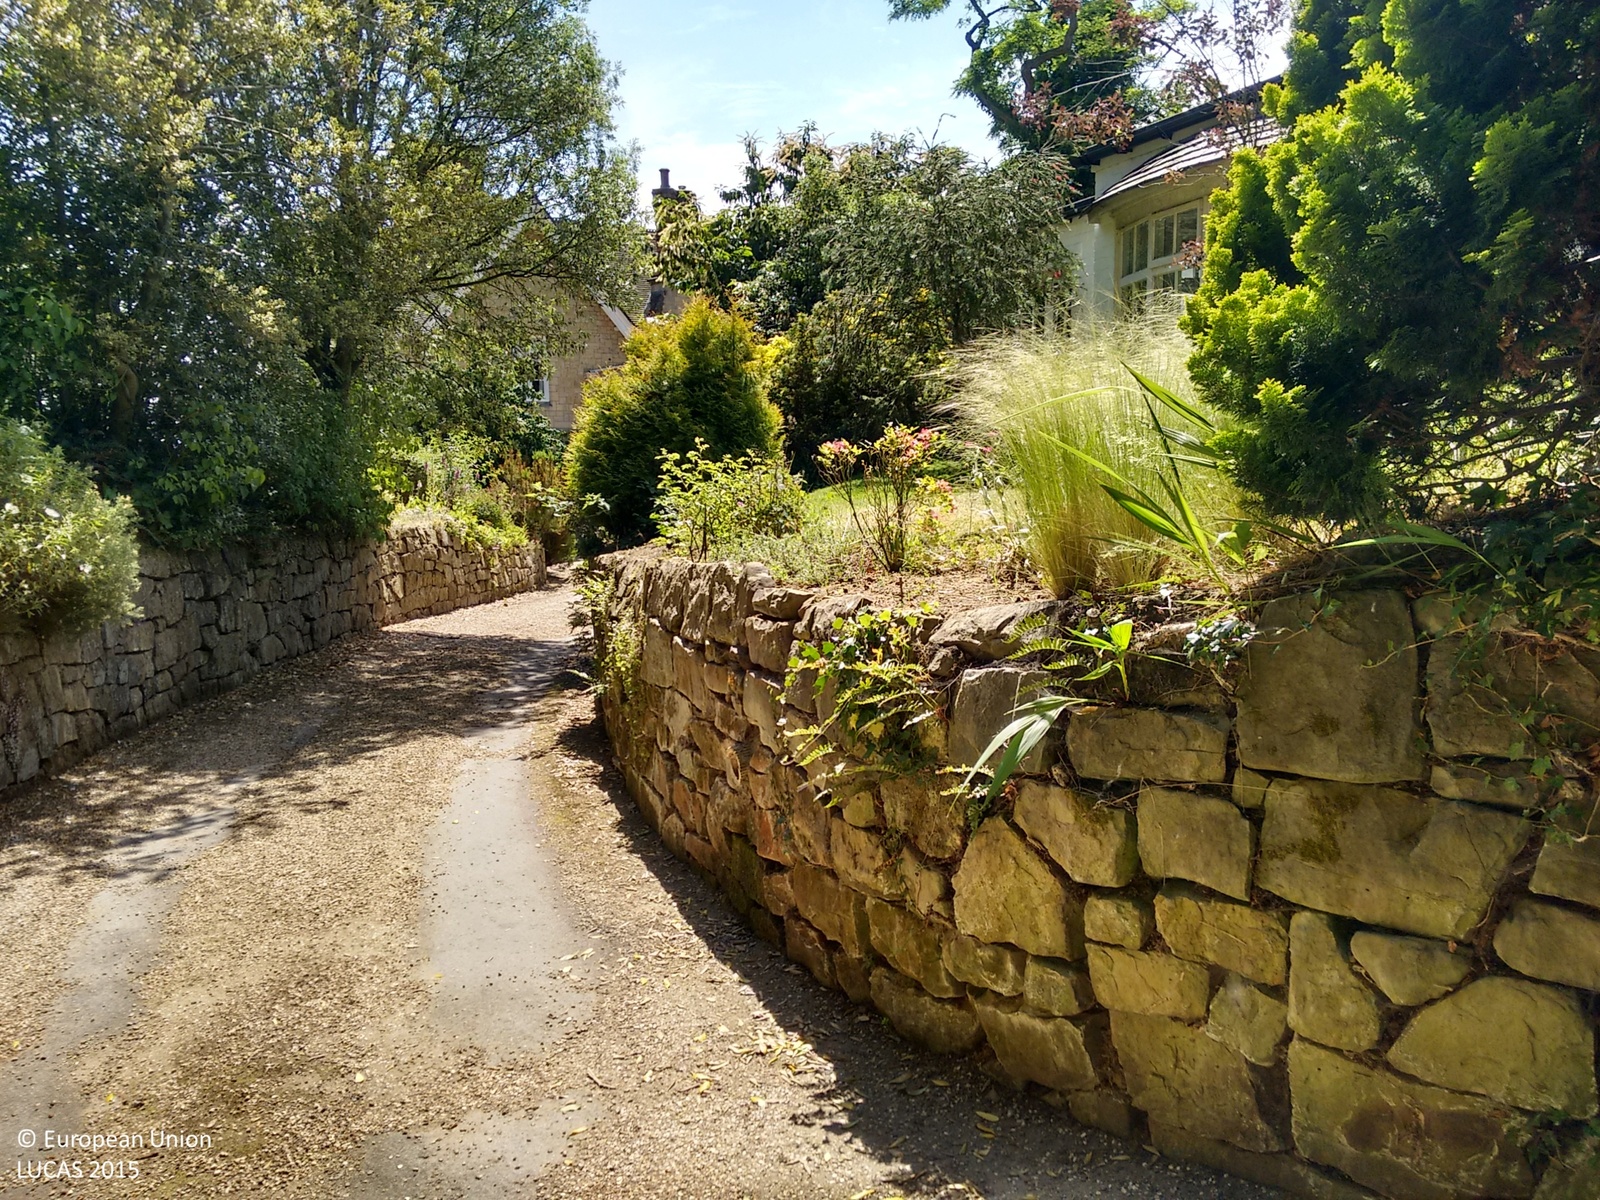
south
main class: Grassland
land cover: Grassland with sparse tree/shrub cover
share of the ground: > 75 %
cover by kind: herbaceous plants 85 %, shrubs 10 %, broadleaved forest trees 5 %
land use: Residential
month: June
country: GB
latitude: 51.2286
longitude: -0.2170
